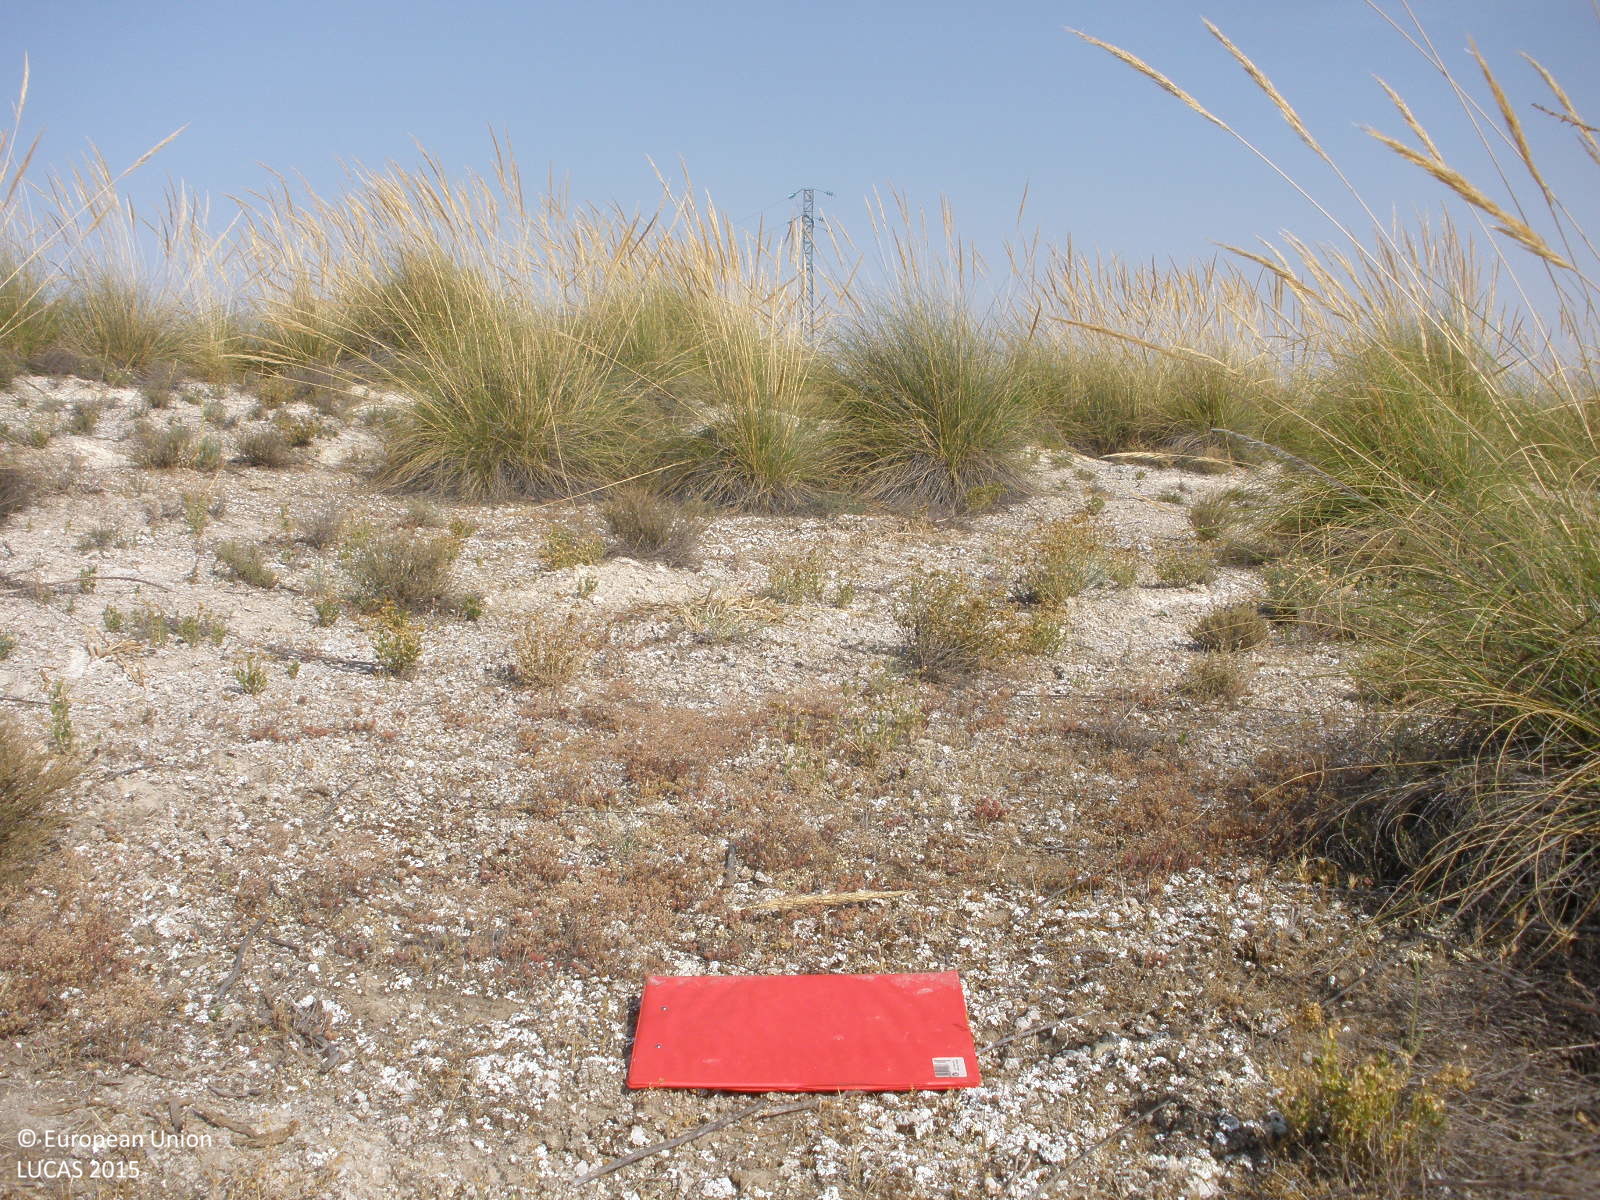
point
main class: Shrubland
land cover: Shrubland without tree cover
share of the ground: 25 - 50 %
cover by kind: shrubs 40 %, herbaceous plants 30 %, consolidated bare surface 30 %
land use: Semi-natural and natural areas not in use
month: July
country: ES
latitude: 40.0633
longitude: -3.3589
